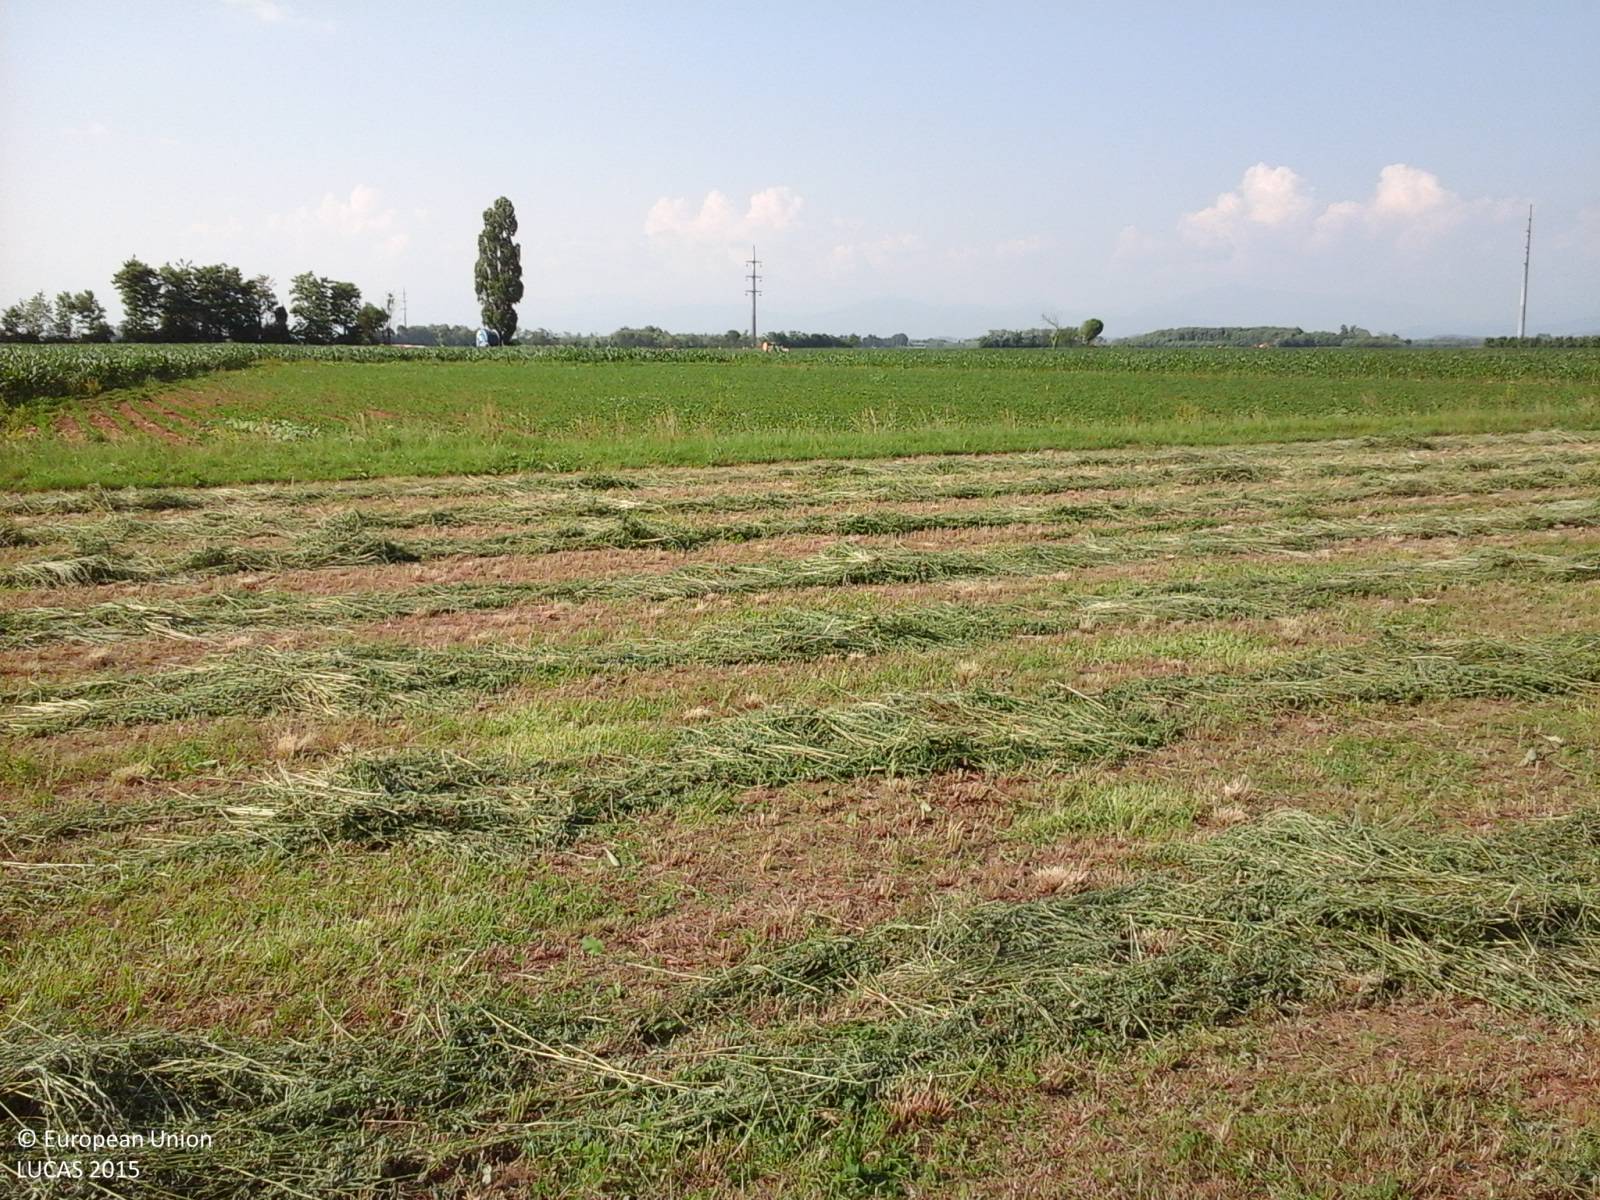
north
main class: Cropland
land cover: Lucerne
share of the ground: > 75 %
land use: Agriculture (excluding fallow land and kitchen gardens)
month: June
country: IT
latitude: 45.9214
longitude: 13.3100
